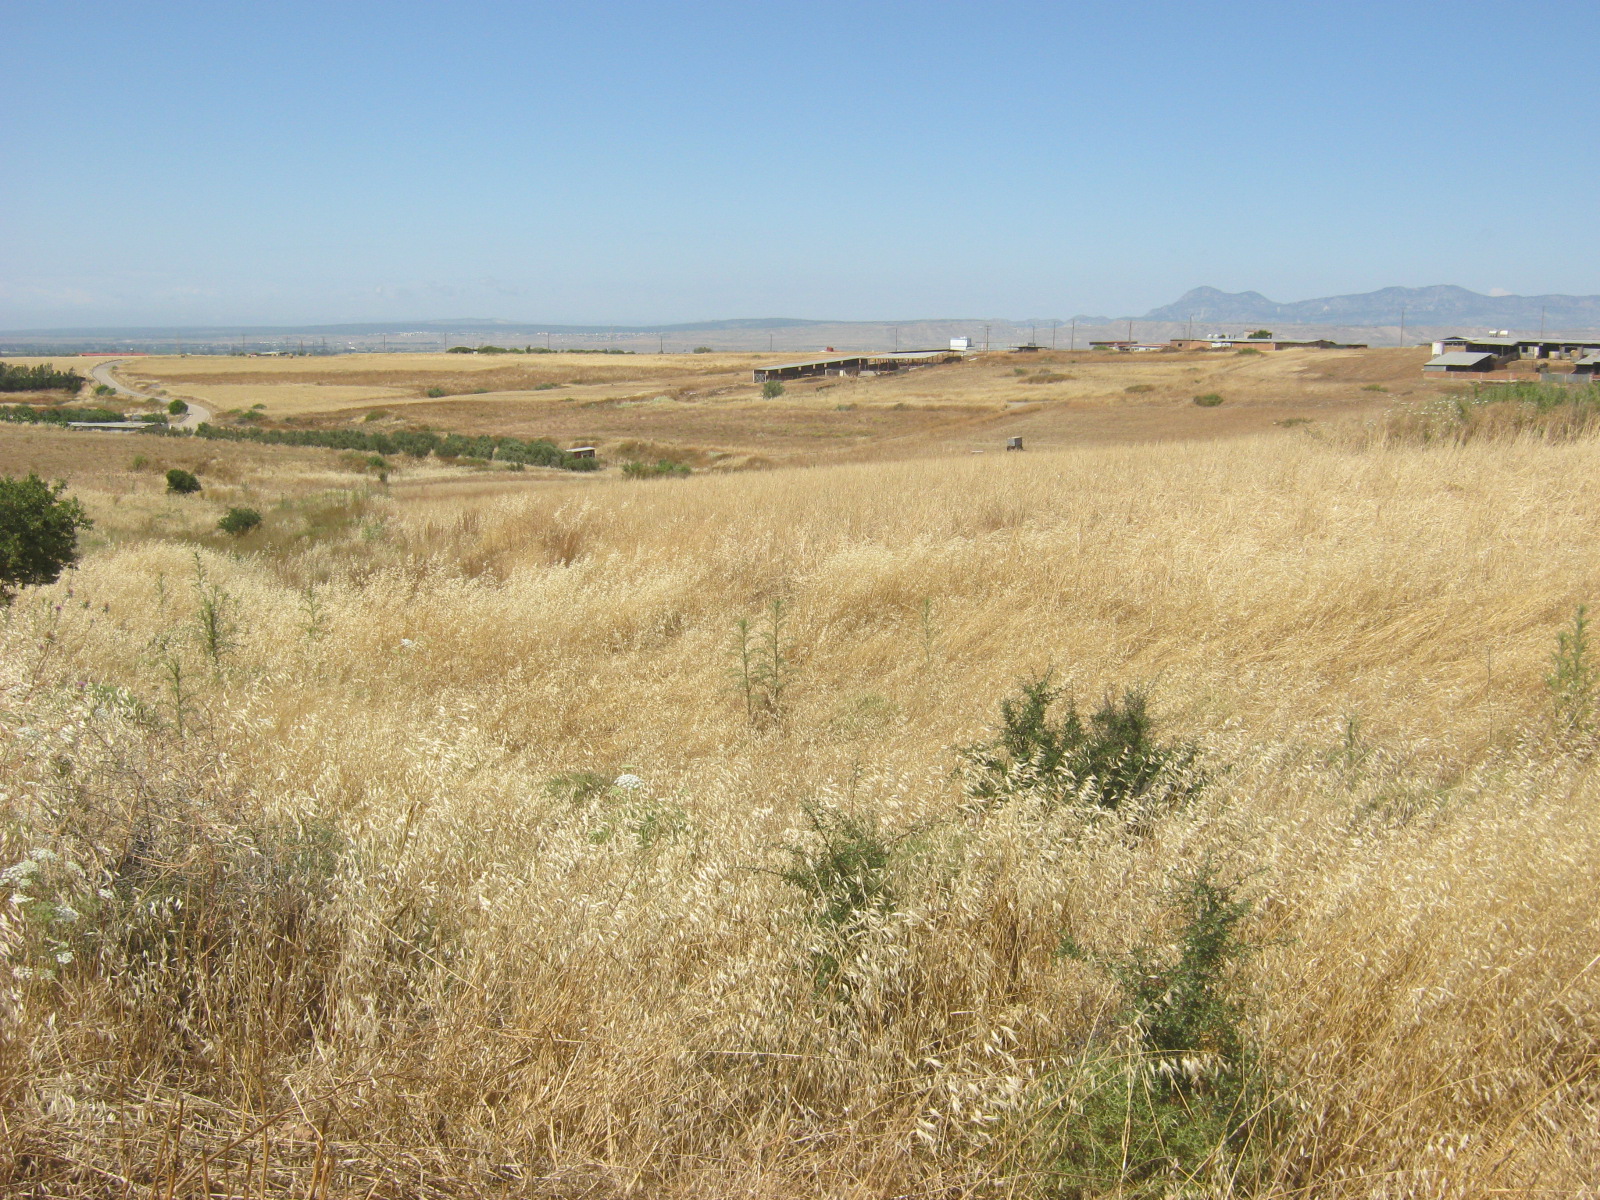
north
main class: Grassland
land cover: Grassland with sparse tree/shrub cover
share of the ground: > 75 %
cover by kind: herbaceous plants 95 %, broadleaved forest trees 5 %
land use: Semi-natural and natural areas not in use
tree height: < 5 m
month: May
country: CY
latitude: 35.1222
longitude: 33.0363
